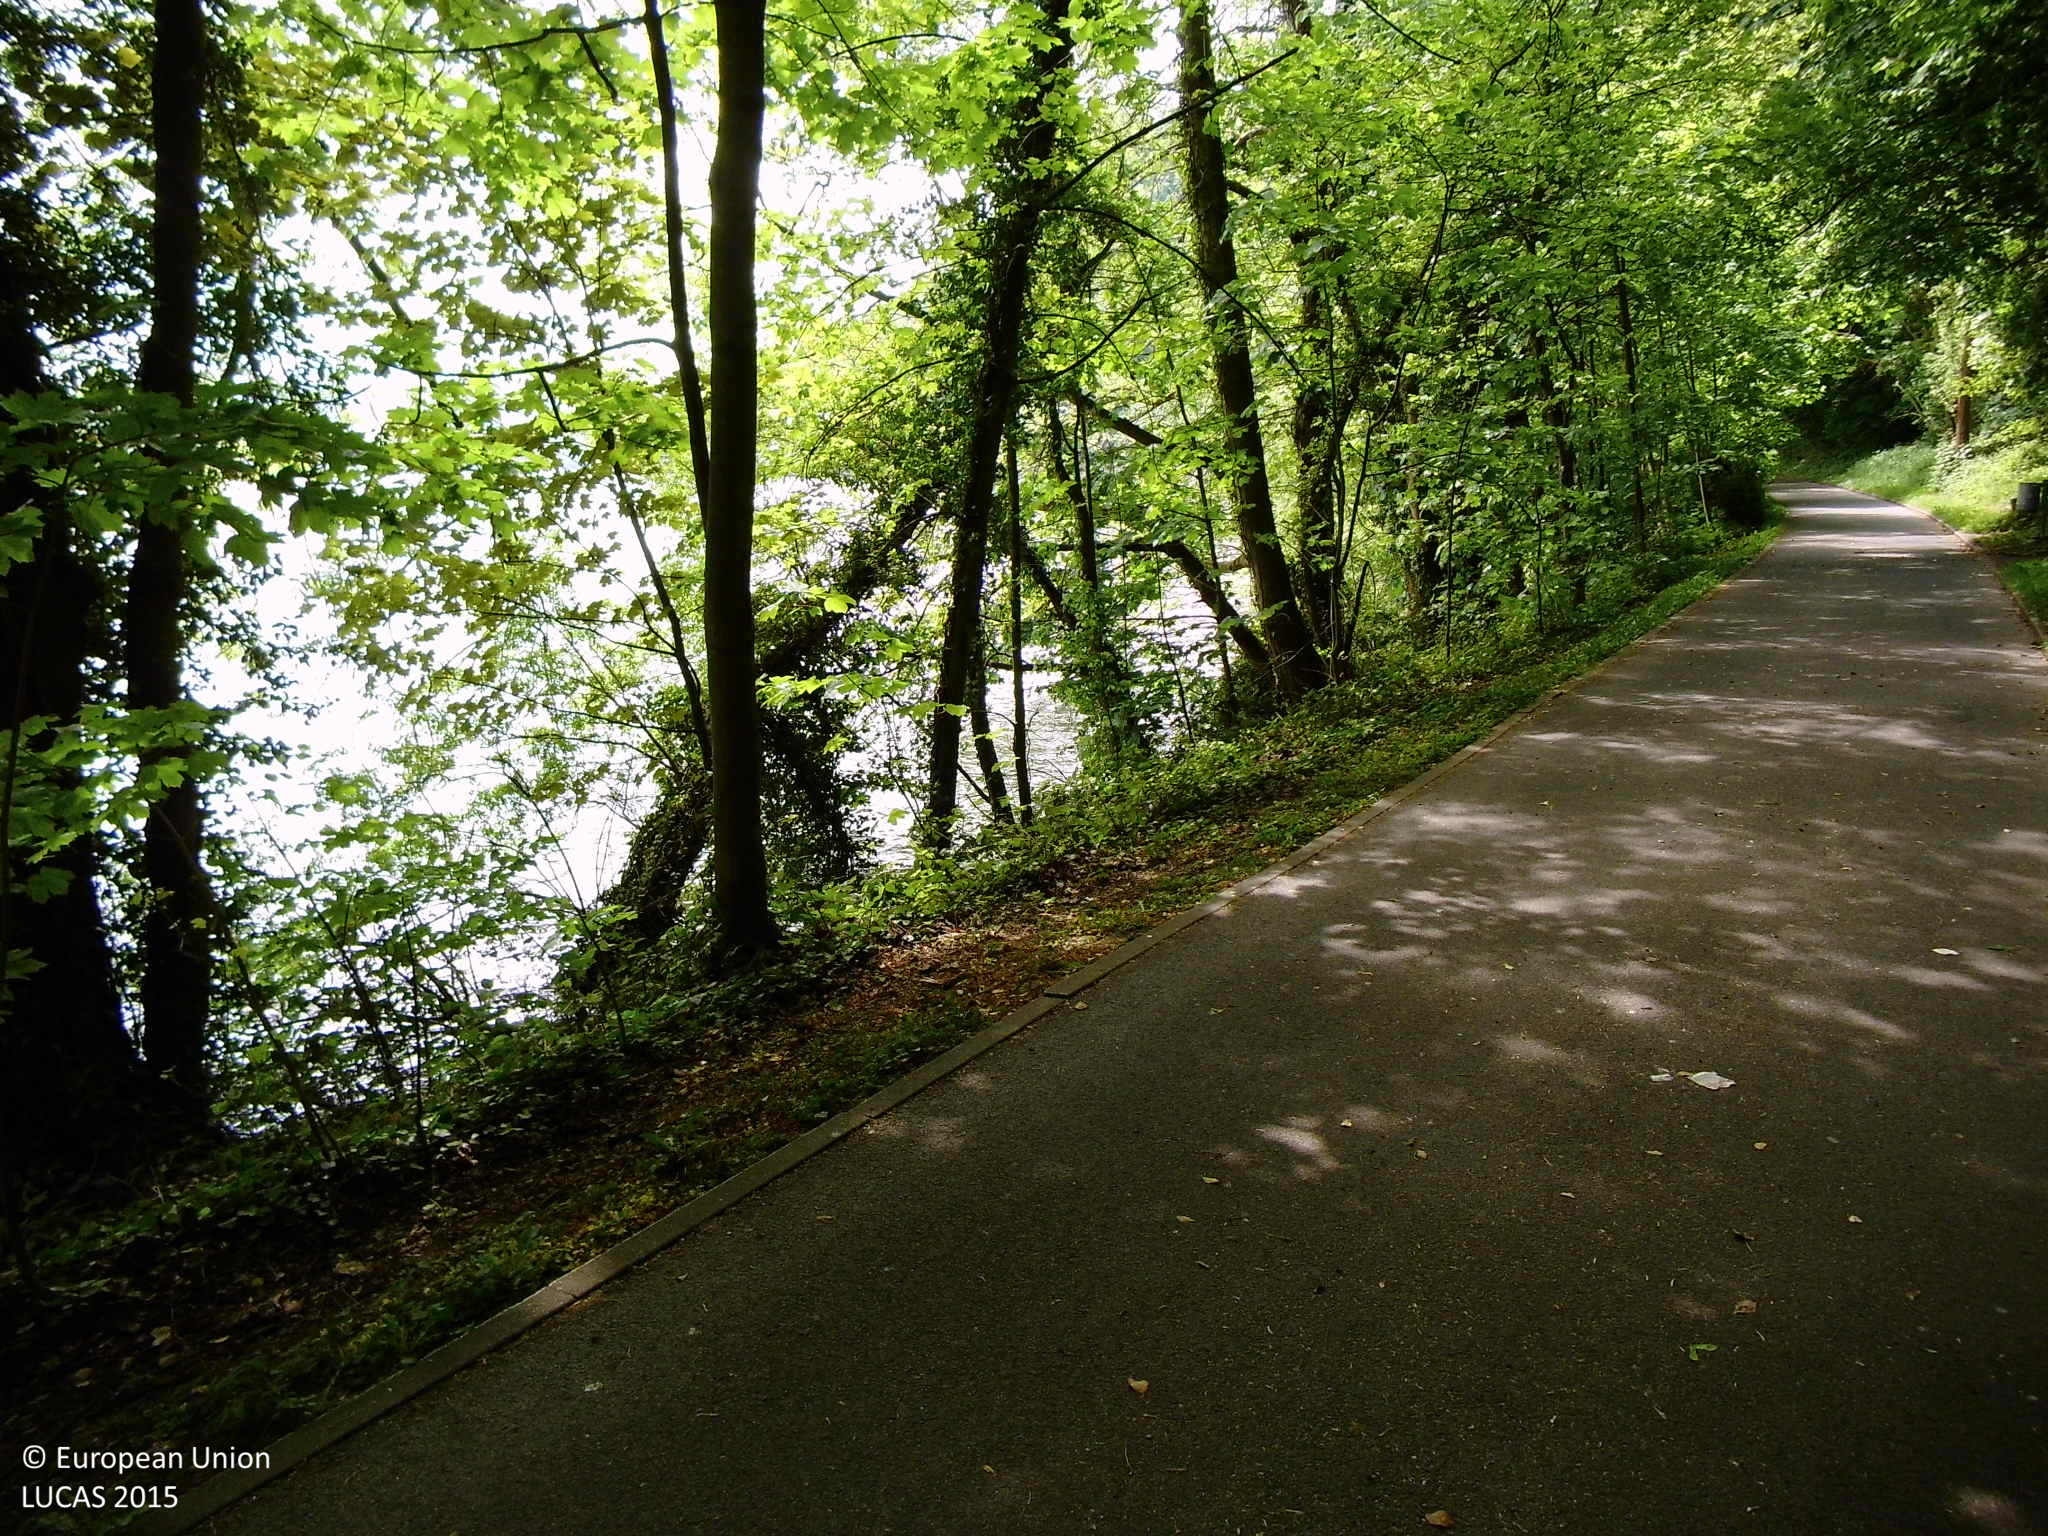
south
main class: Woodland
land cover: Broadleaved woodland
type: beech forest
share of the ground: > 75 %
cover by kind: broadleaved forest trees 100 %
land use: Forestry
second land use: Amenities, museums, leisure
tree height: > 5 m
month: May
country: DE
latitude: 51.3958
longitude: 7.3987
